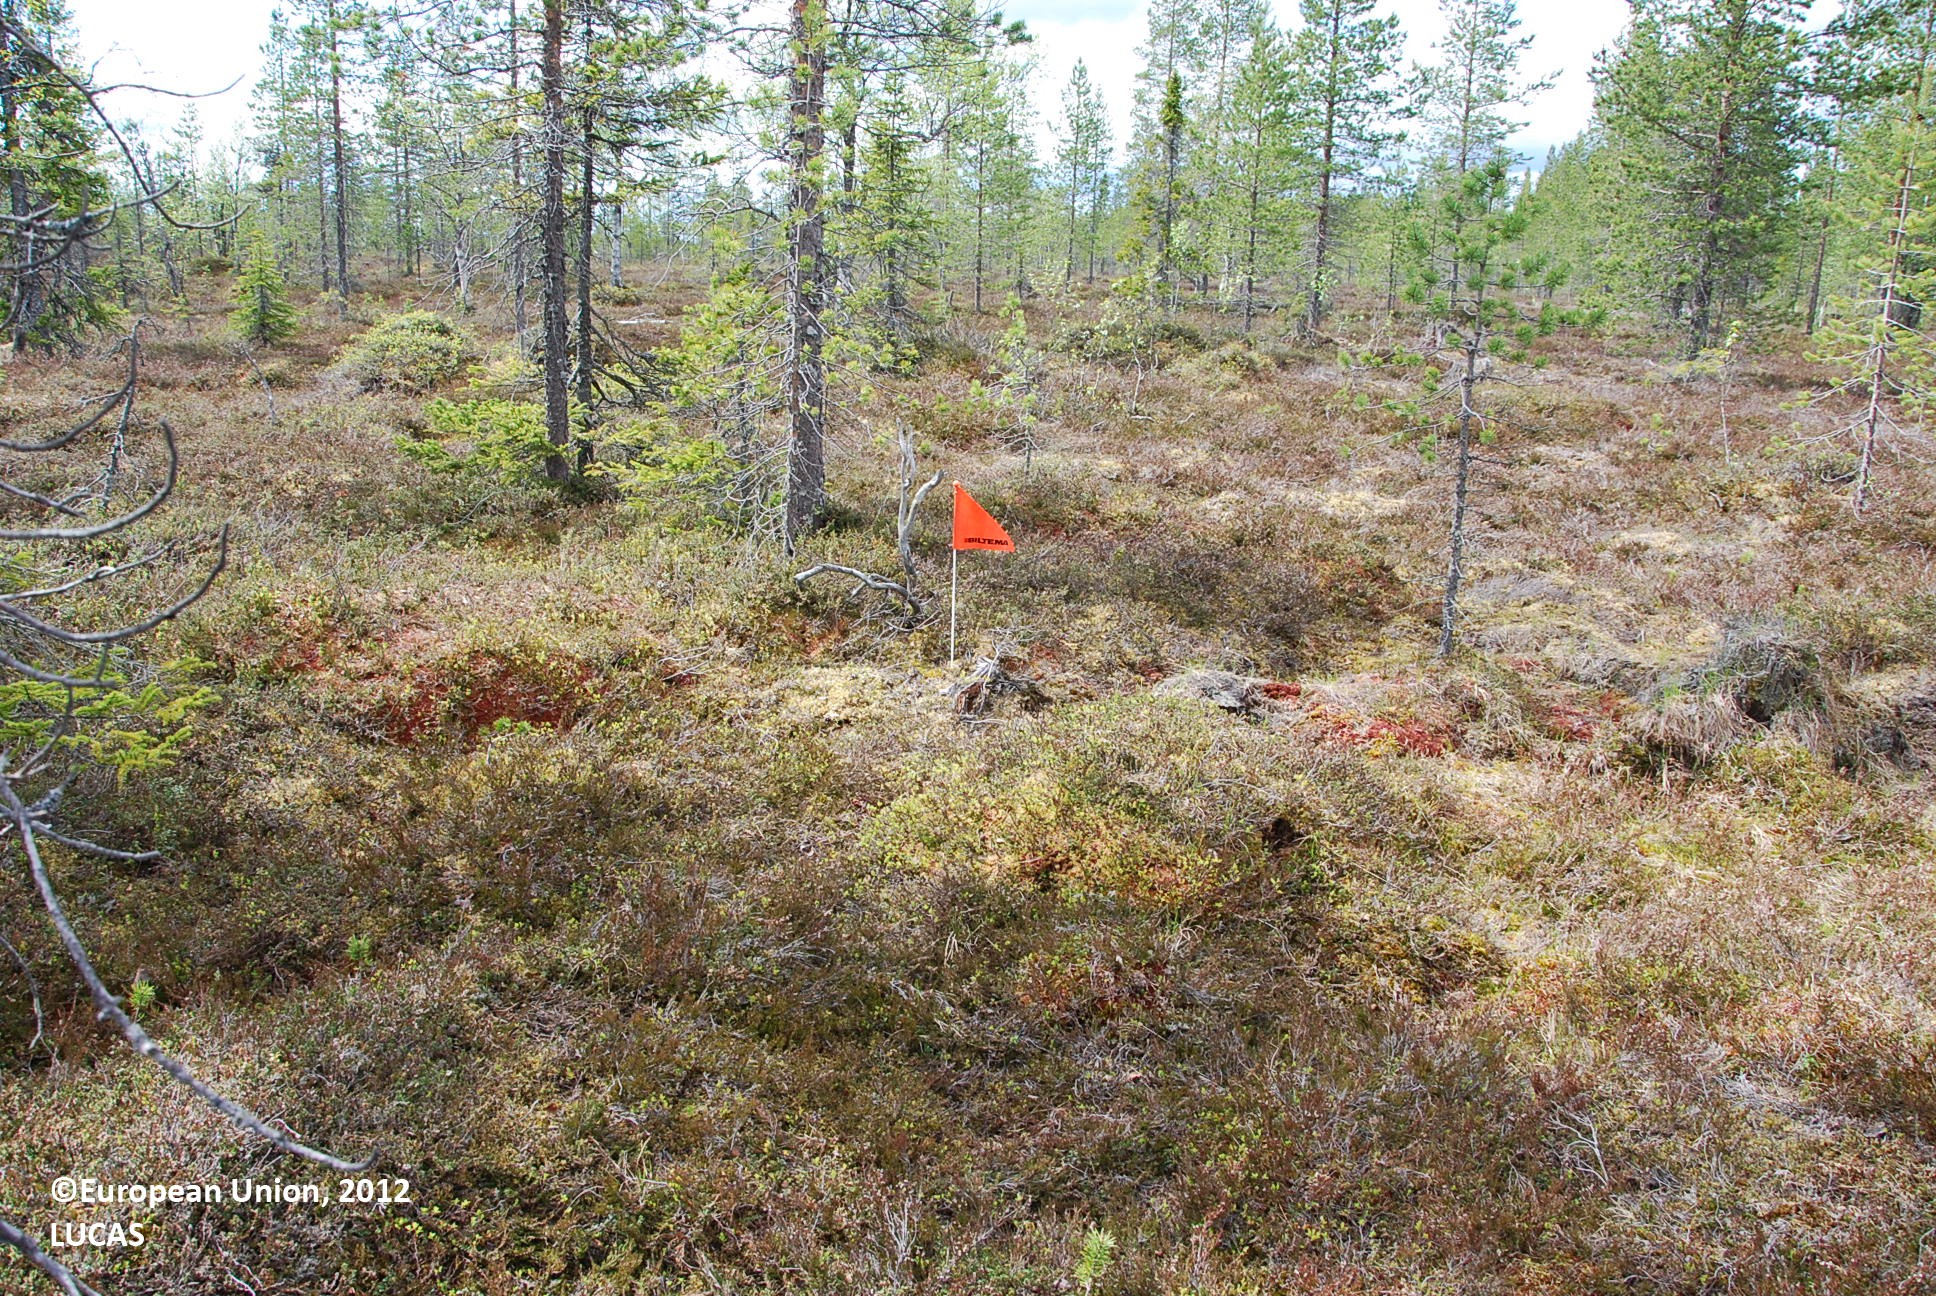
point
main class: Woodland
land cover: Pine dominated mixed woodland
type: boreal forest
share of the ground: 25 - 50 %
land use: Forestry
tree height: > 5 m
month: June
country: FI
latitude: 66.1842
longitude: 27.7253
